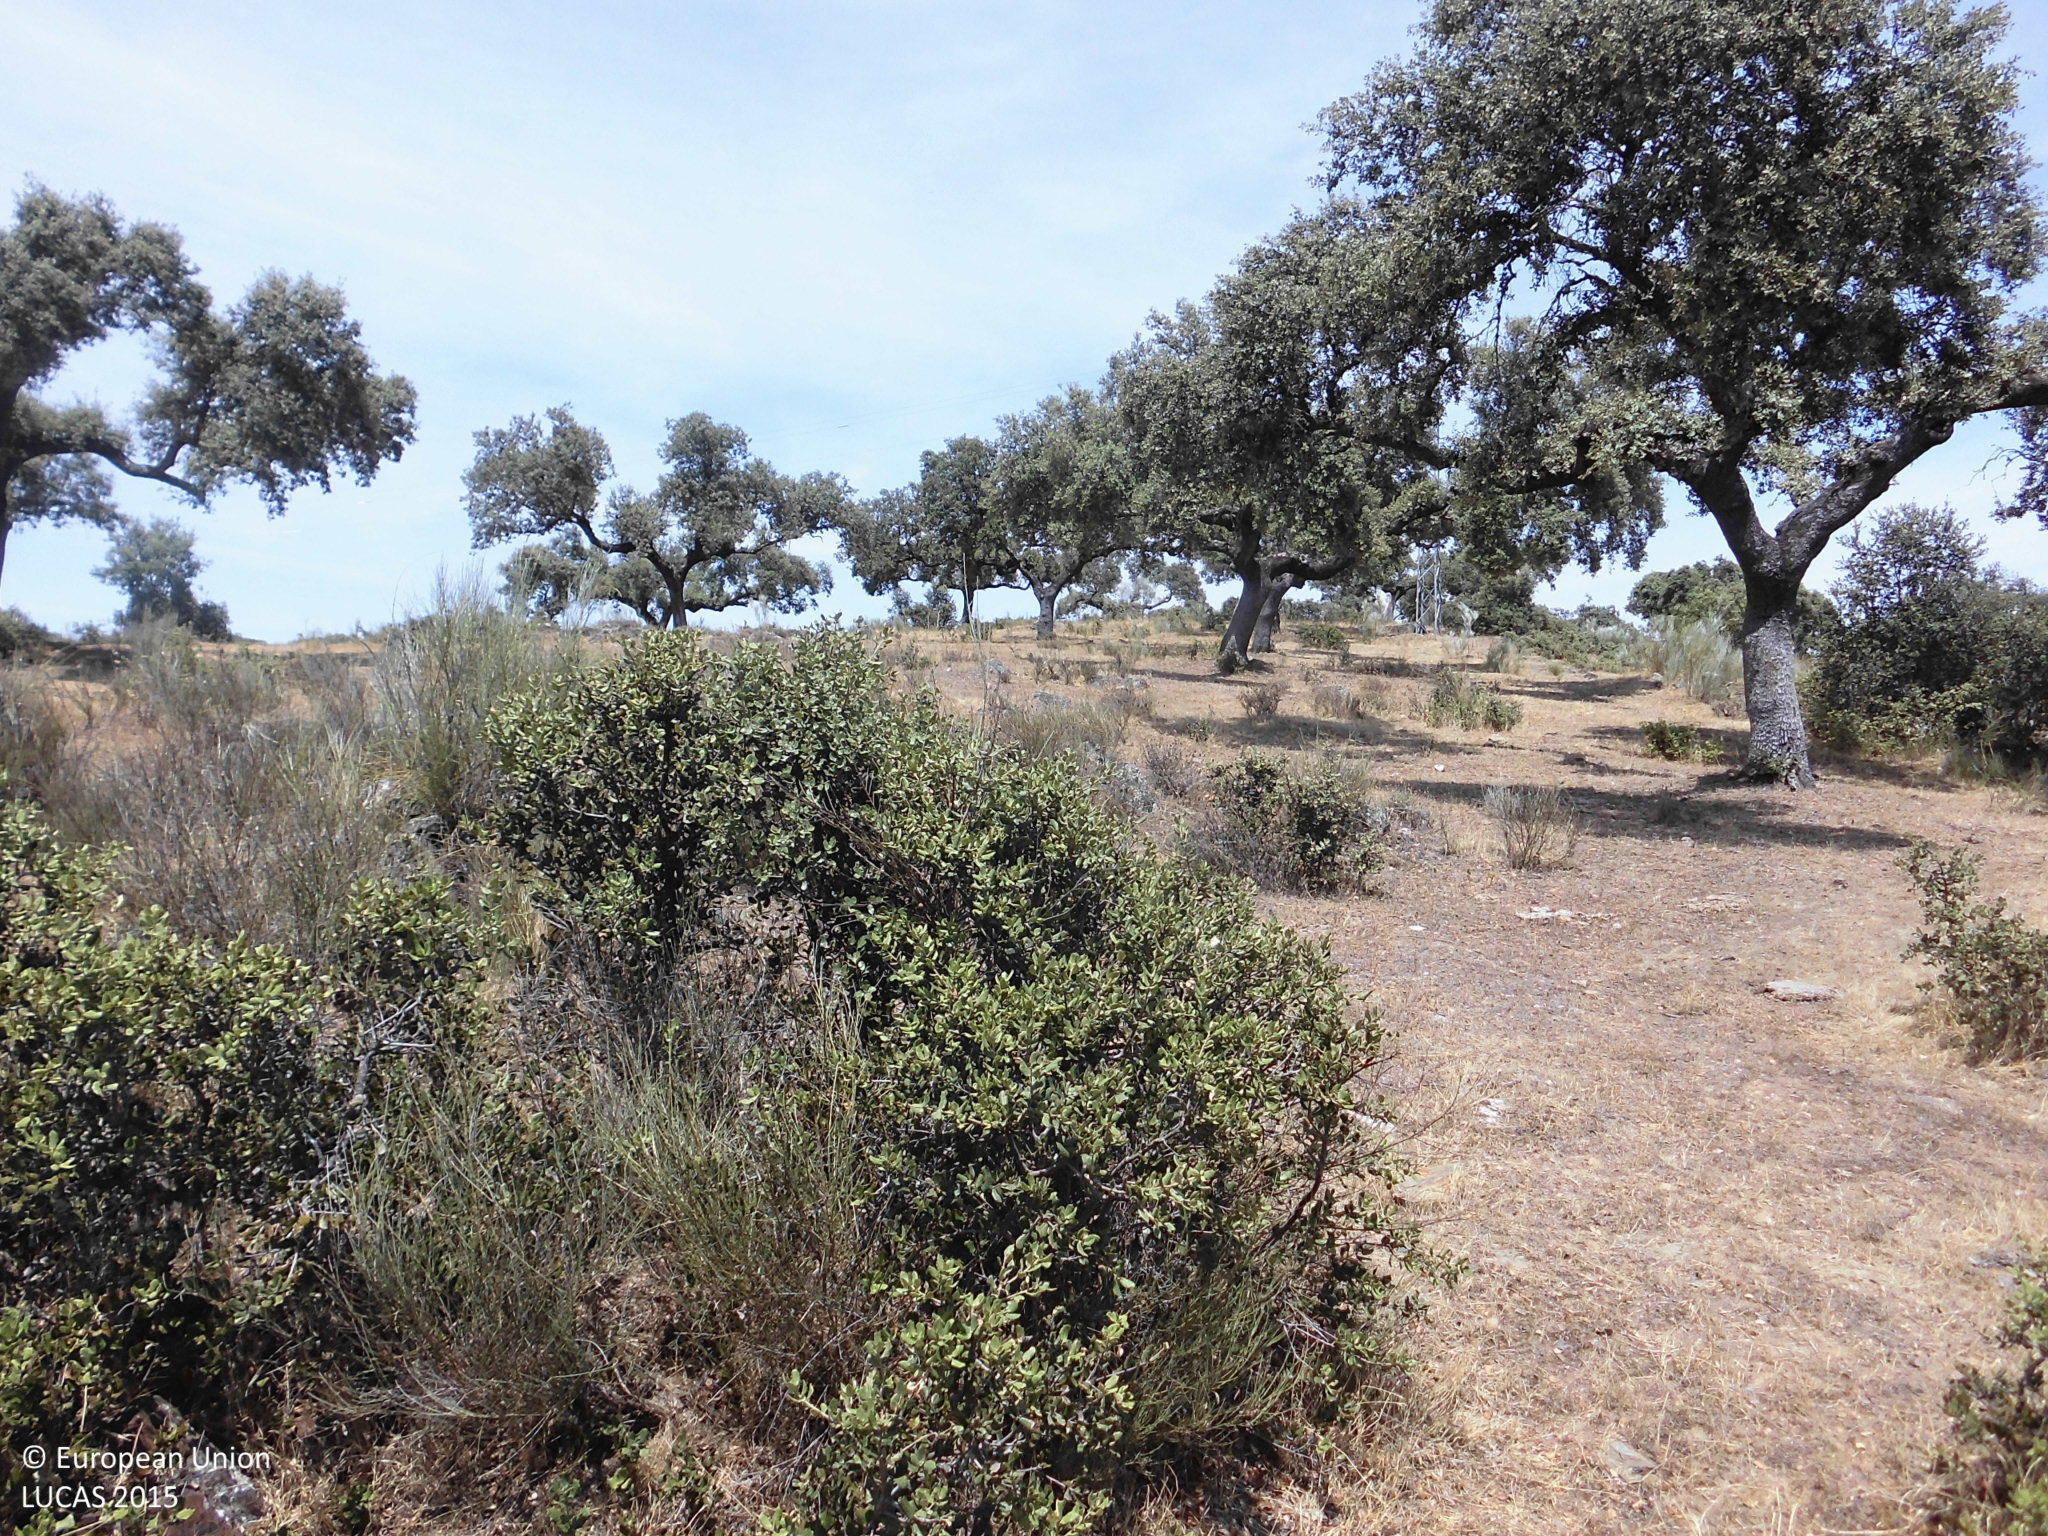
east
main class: Woodland
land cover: Broadleaved woodland
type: broadleaved evergreen forest
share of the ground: 10 - 25 %
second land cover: Grassland without tree/shrub cover
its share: > 75 %
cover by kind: herbaceous plants 85 %, broadleaved forest trees 15 %
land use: Forestry
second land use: Agriculture (excluding fallow land and kitchen gardens)
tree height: > 5 m
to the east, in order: Broadleaved woodland; Grassland without tree/shrub cover; Broadleaved woodland; Rivers and streams; Broadleaved woodland
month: July
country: ES
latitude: 39.9032
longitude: -6.5360
